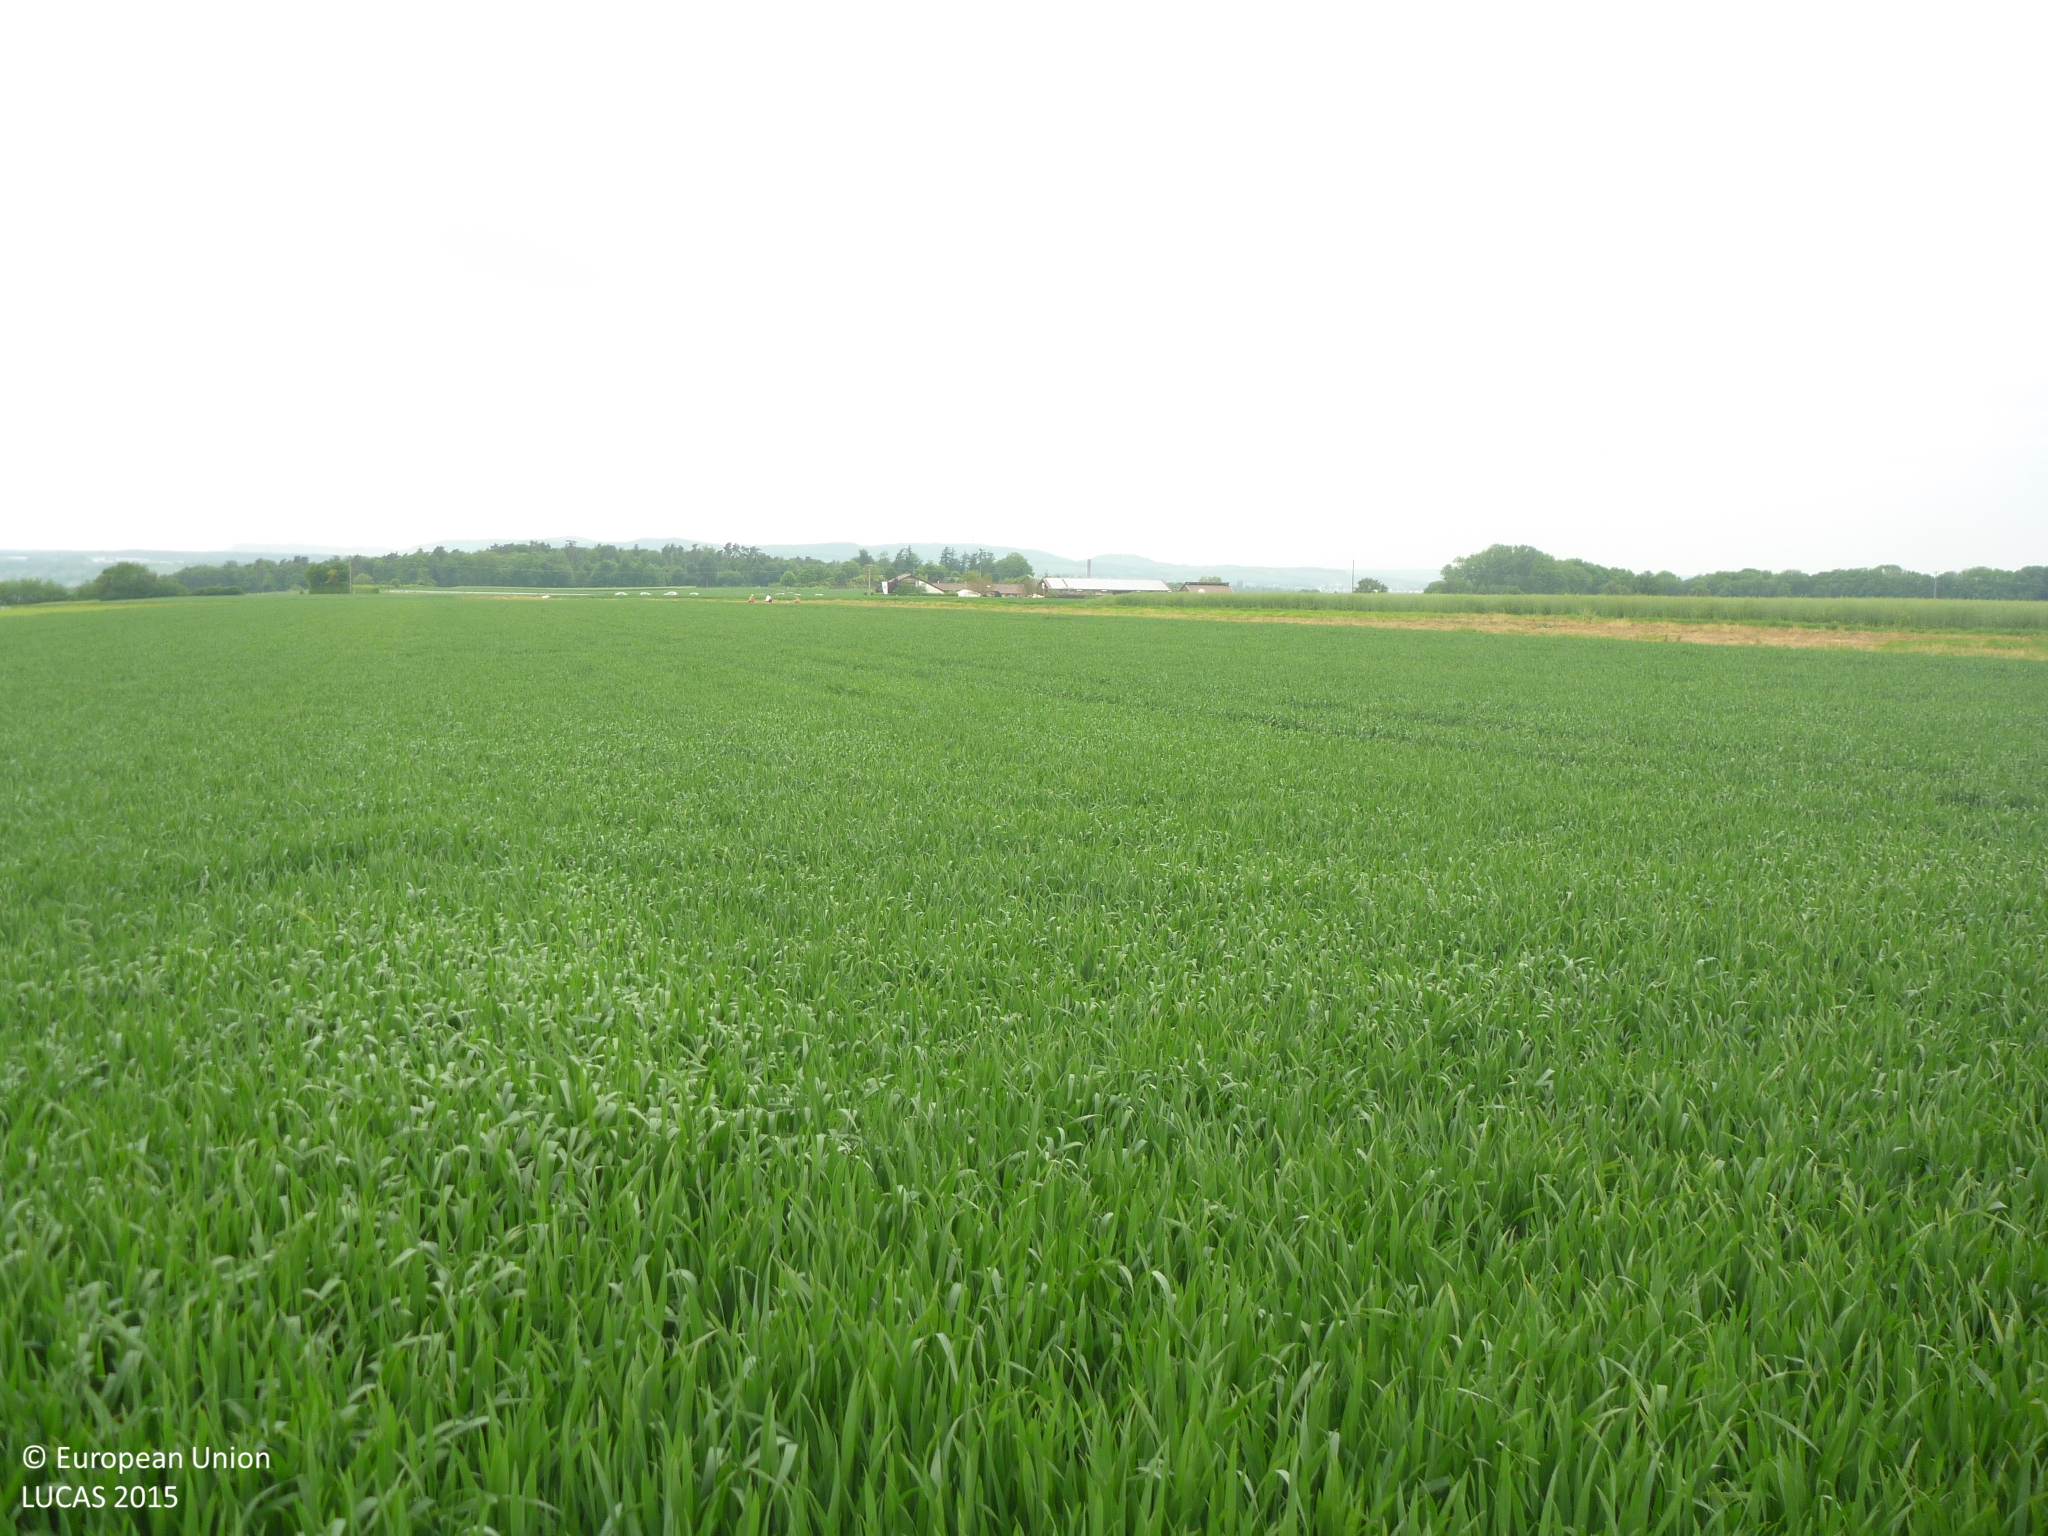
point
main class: Cropland
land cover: Common wheat
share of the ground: > 75 %
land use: Agriculture (excluding fallow land and kitchen gardens)
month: May
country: DE
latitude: 49.0123
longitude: 9.1937
